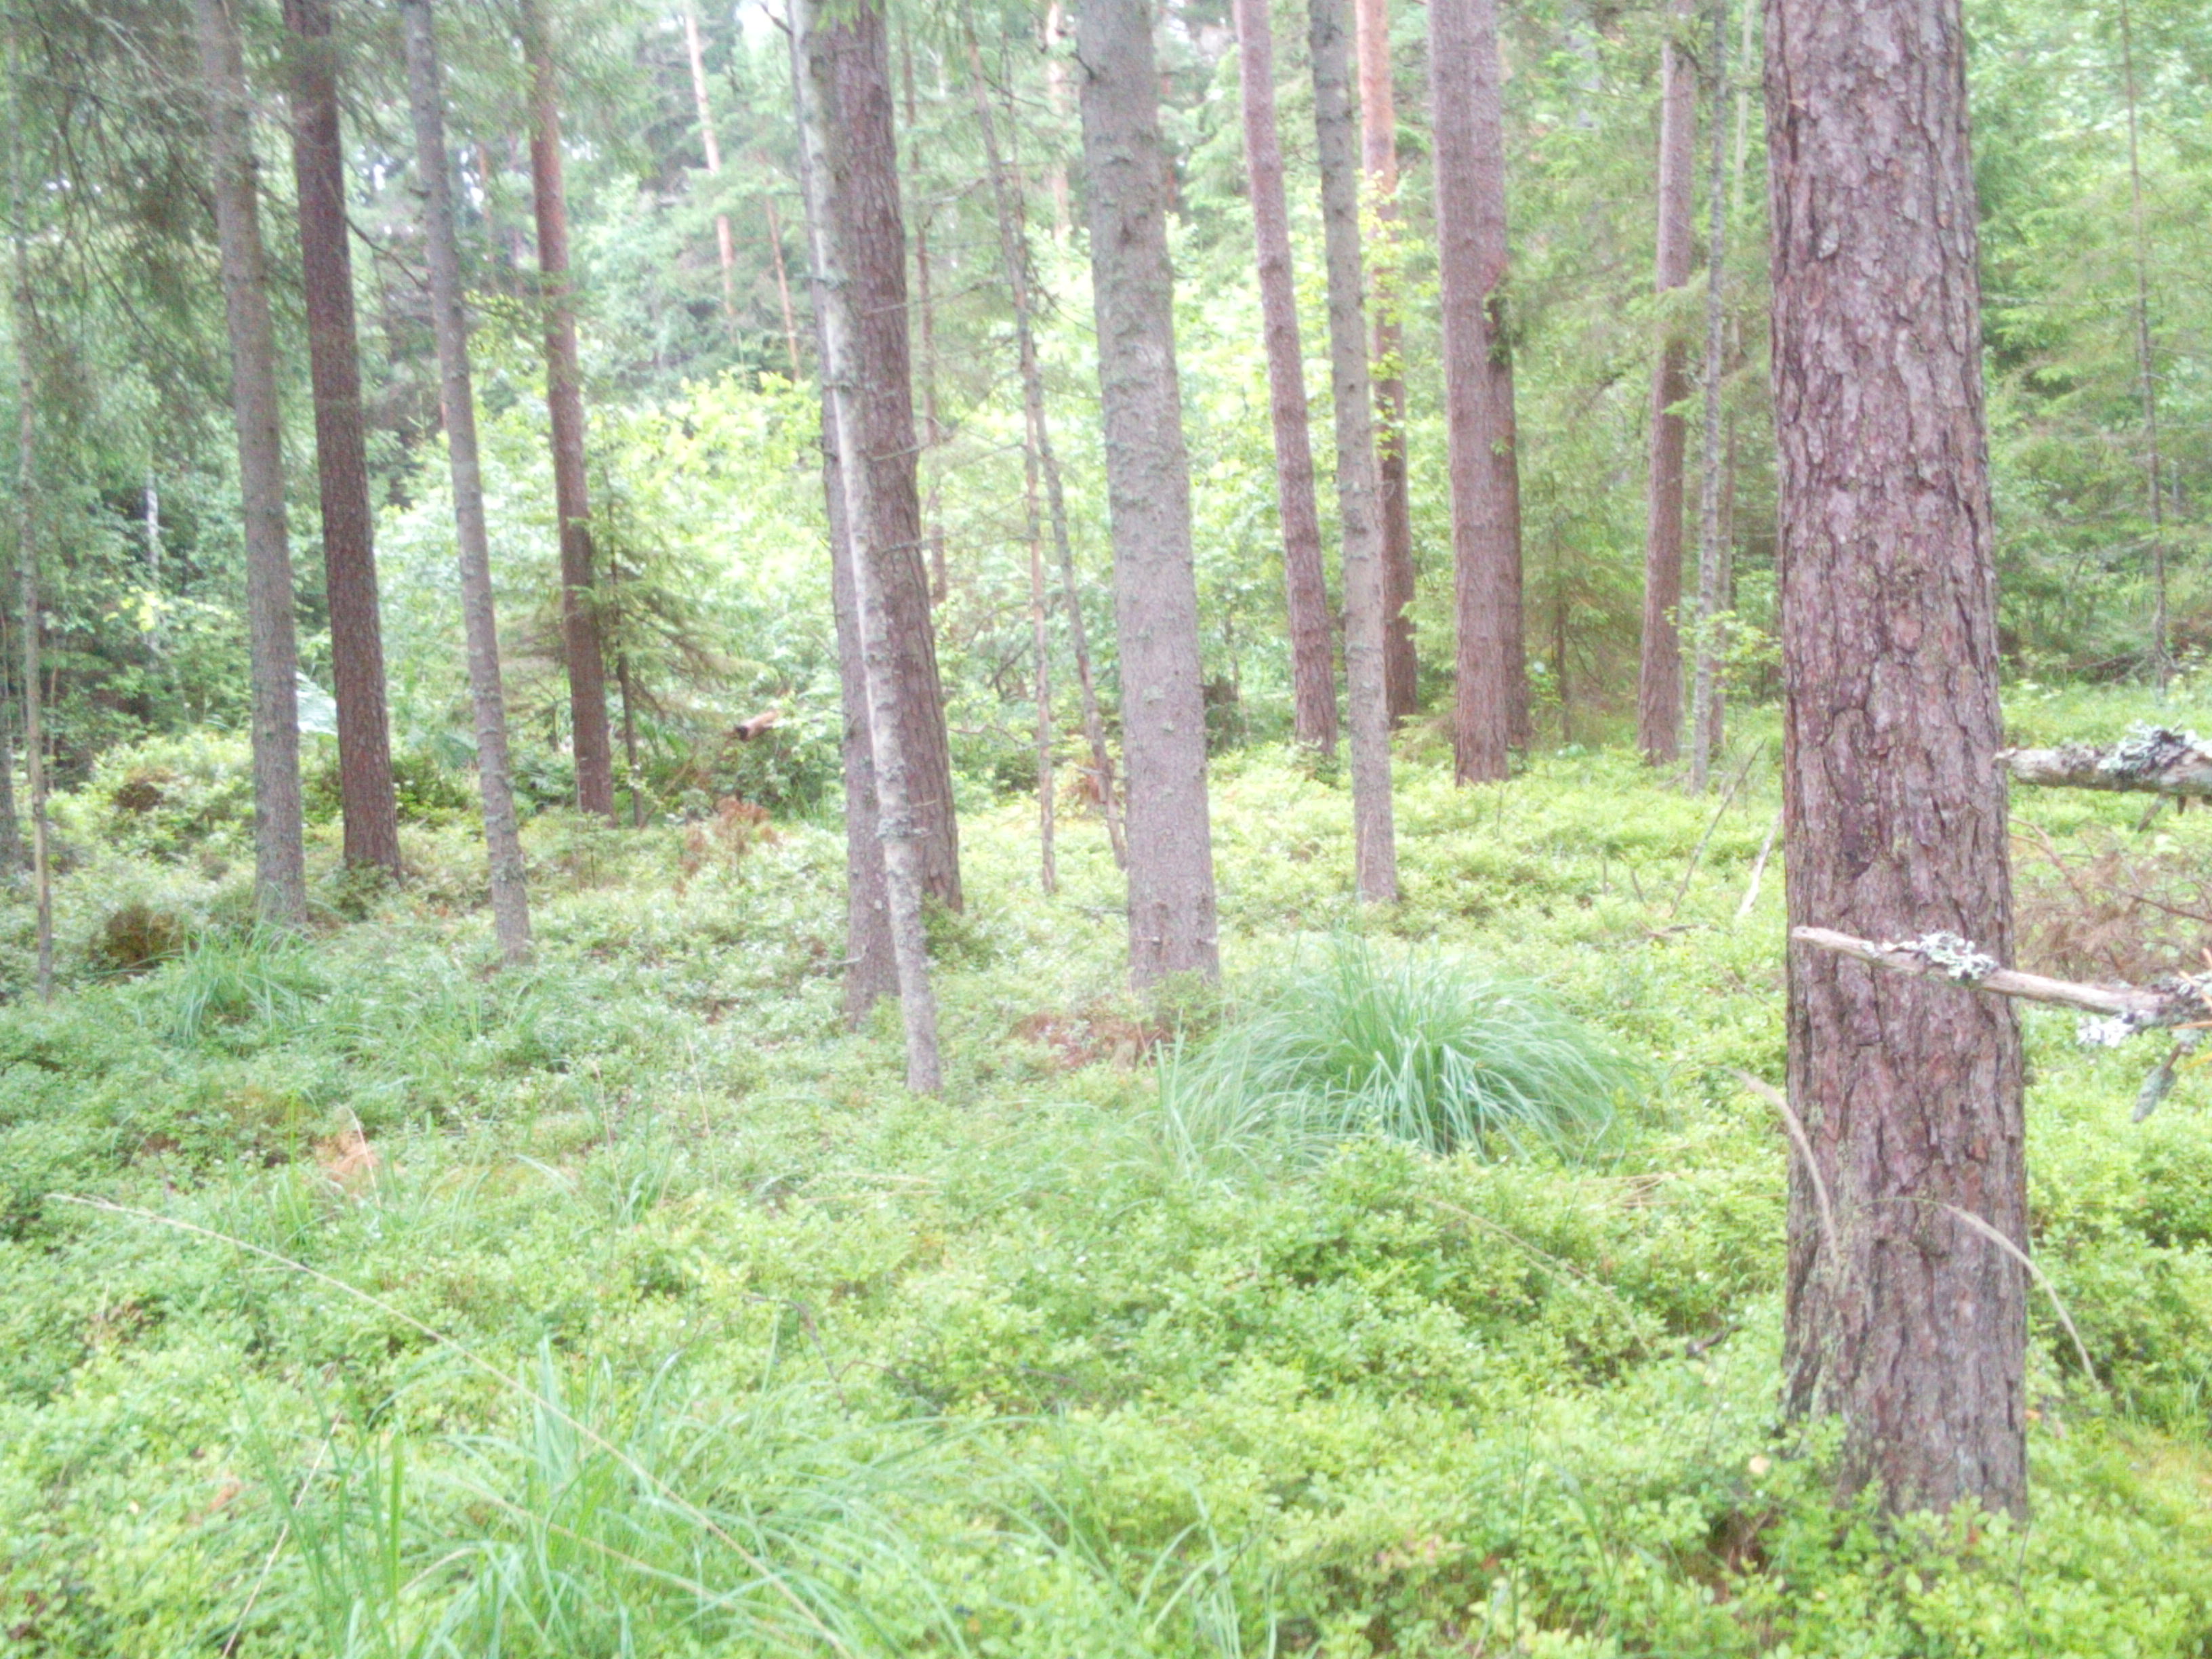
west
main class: Woodland
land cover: Other coniferous woodland
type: hemiboreal forest and nemoral coniferous forest and mixed broadleaved-coniferous forest
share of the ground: > 75 %
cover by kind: coniferous forest trees 75 %, broadleaved forest trees 10 %, lichens and mosses 10 %, herbaceous plants 5 %
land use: Forestry
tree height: > 5 m
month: July
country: LV
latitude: 57.0187
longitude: 22.0554
